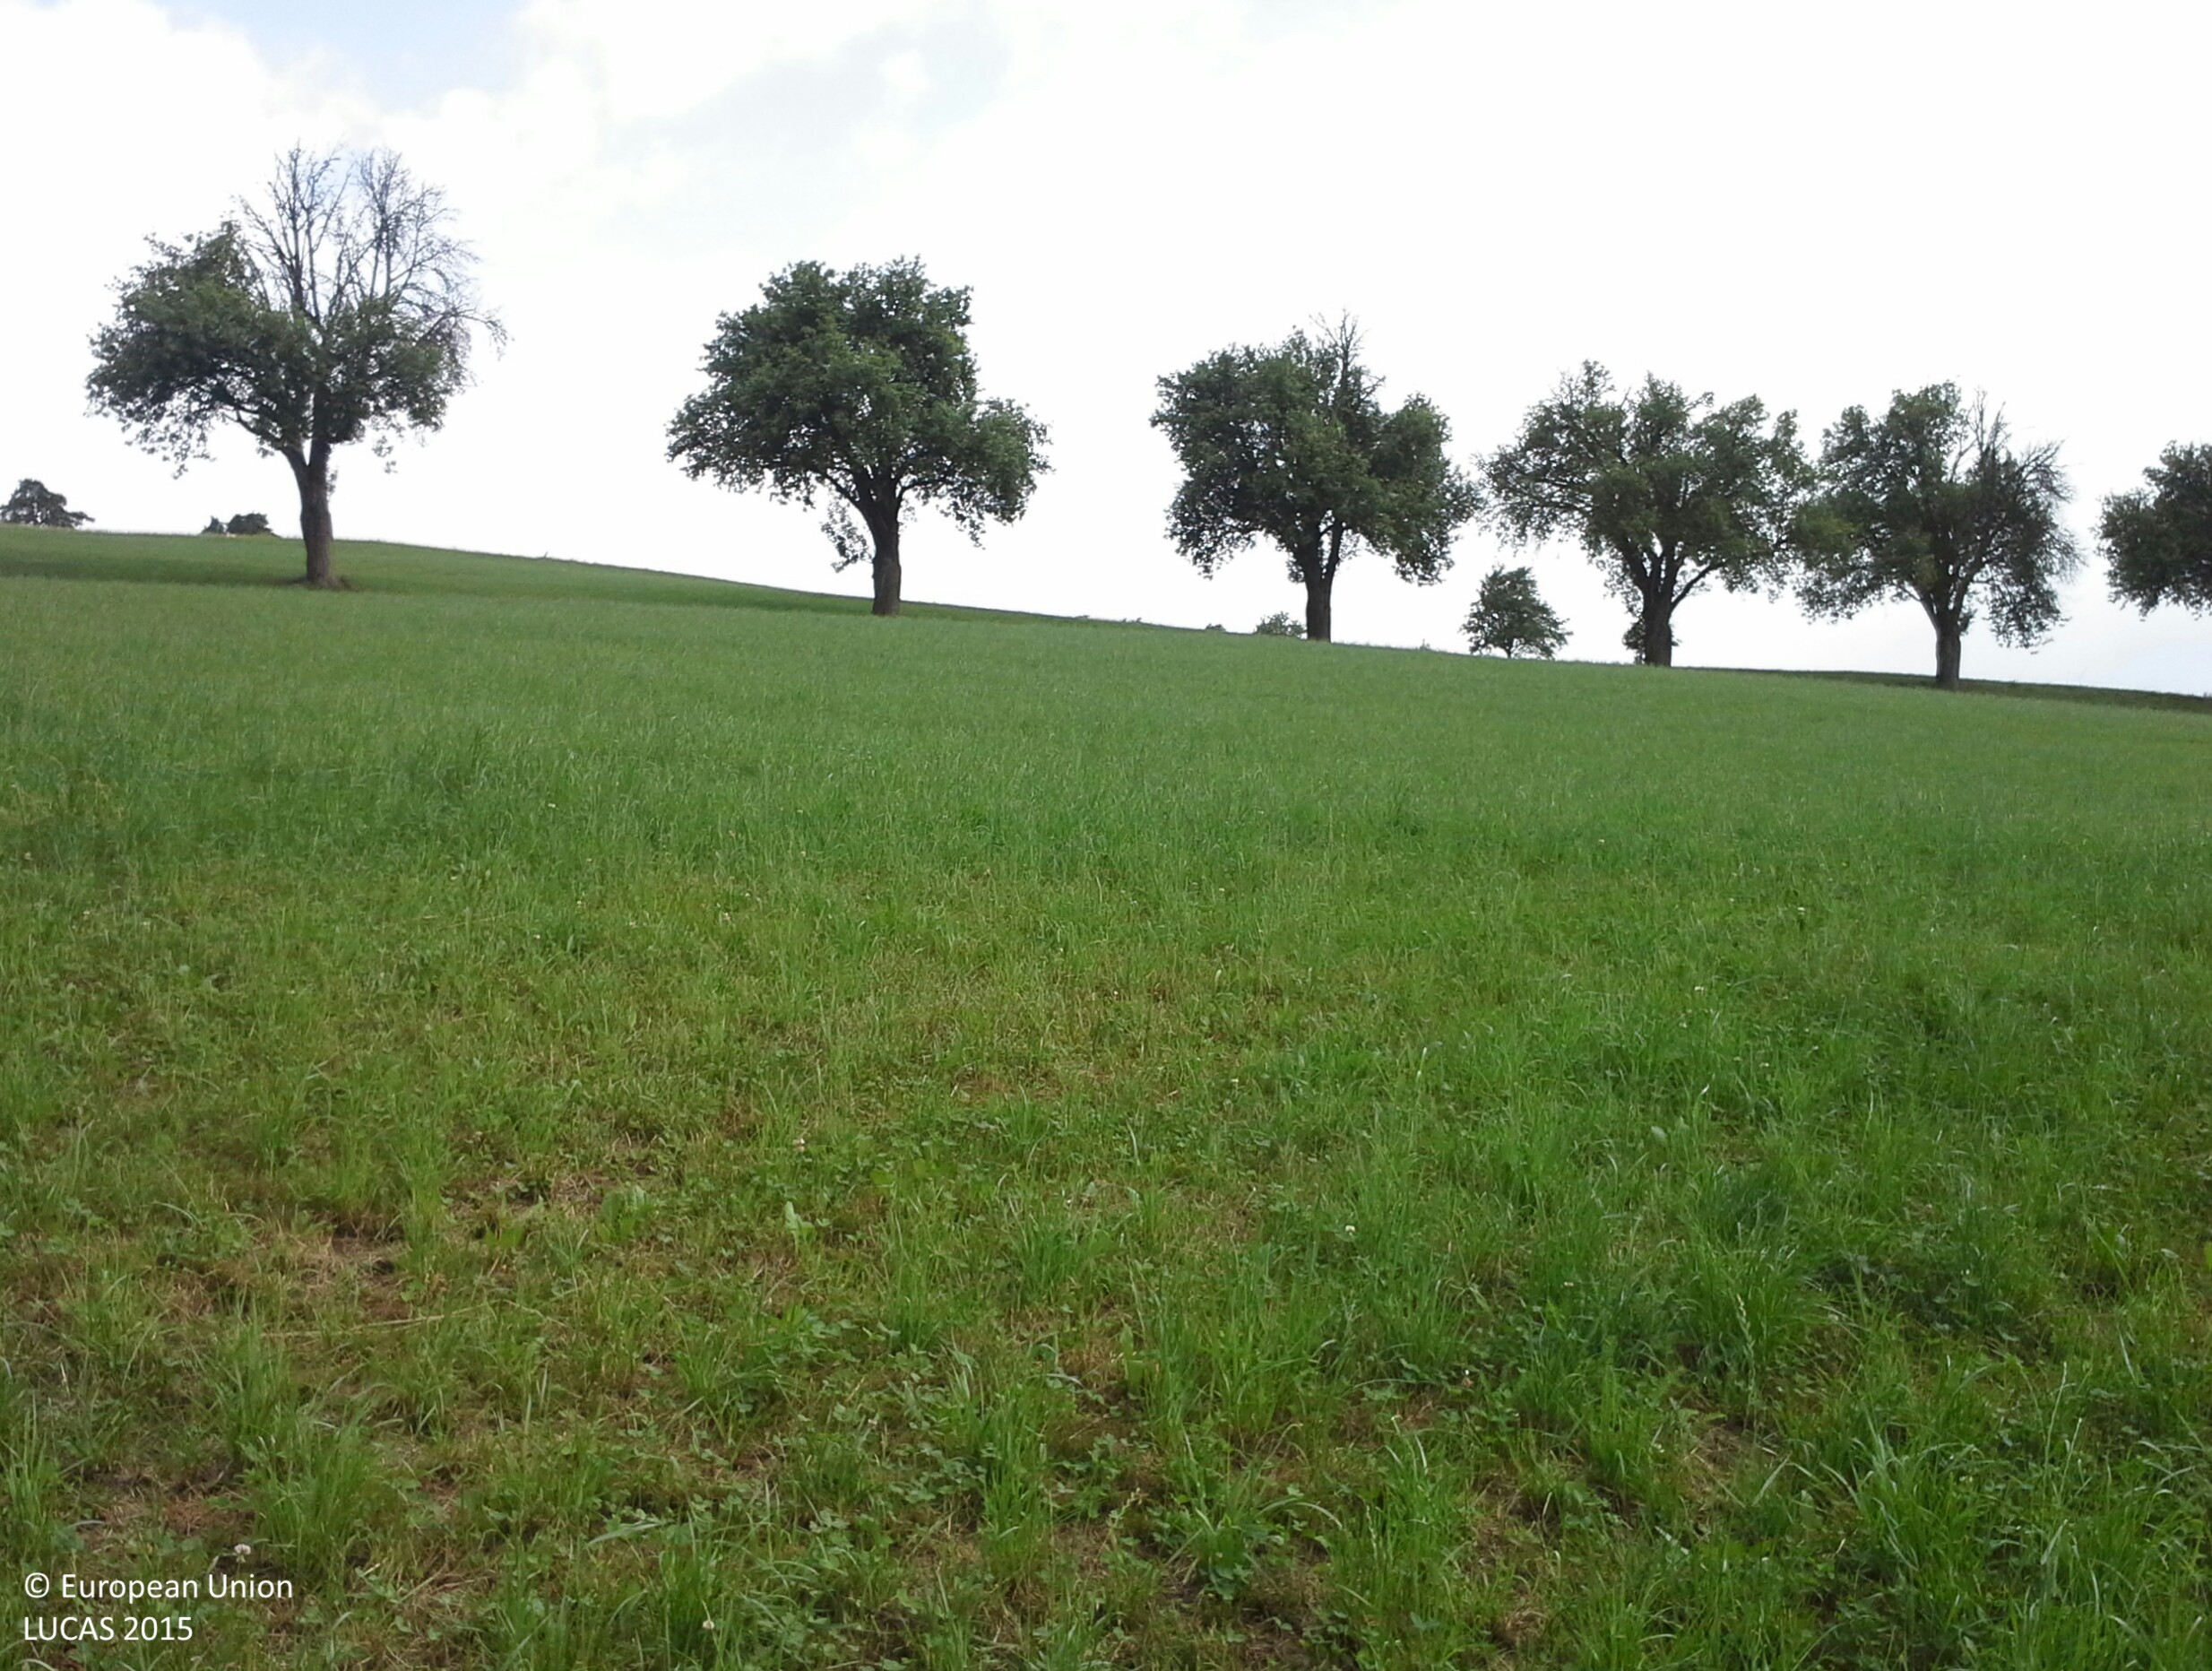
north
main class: Grassland
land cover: Grassland without tree/shrub cover
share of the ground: > 75 %
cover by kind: herbaceous plants 100 %
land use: Agriculture (excluding fallow land and kitchen gardens)
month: July
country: AT
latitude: 48.0026
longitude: 14.5706
